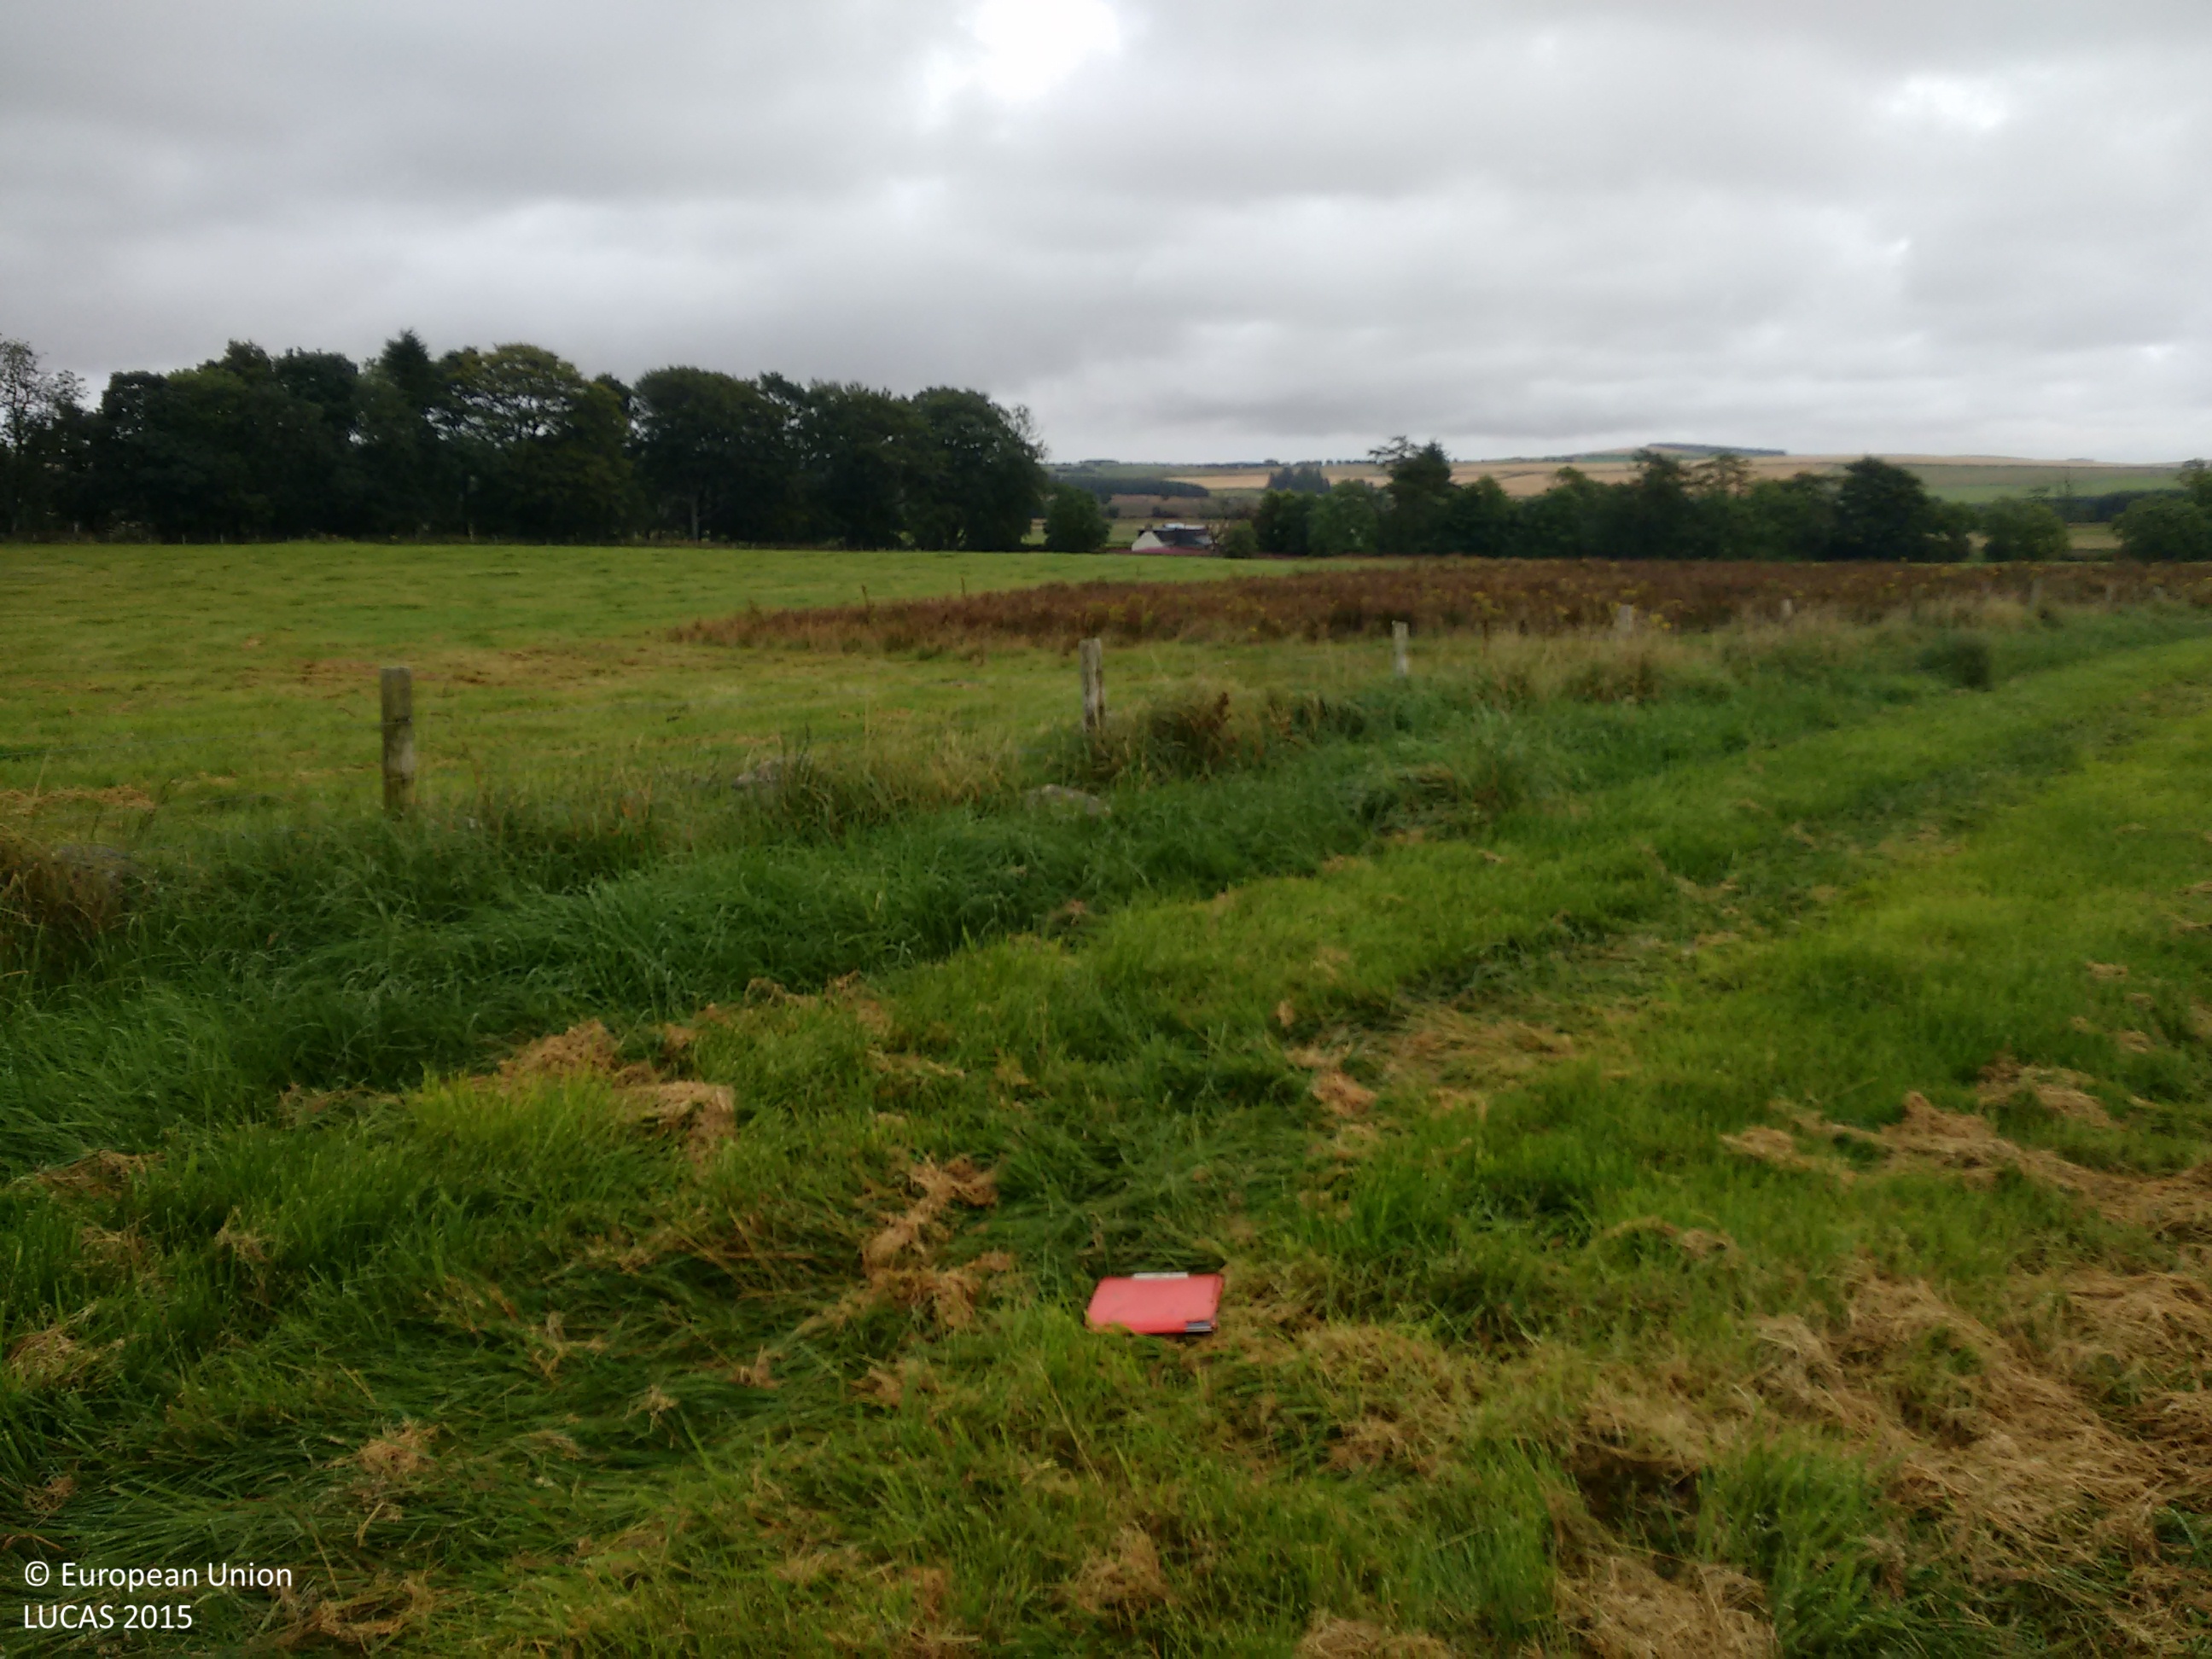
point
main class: Grassland
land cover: Grassland without tree/shrub cover
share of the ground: > 75 %
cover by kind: herbaceous plants 100 %
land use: Agriculture (excluding fallow land and kitchen gardens)
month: September
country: GB
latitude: 57.5968
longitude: -2.6877
